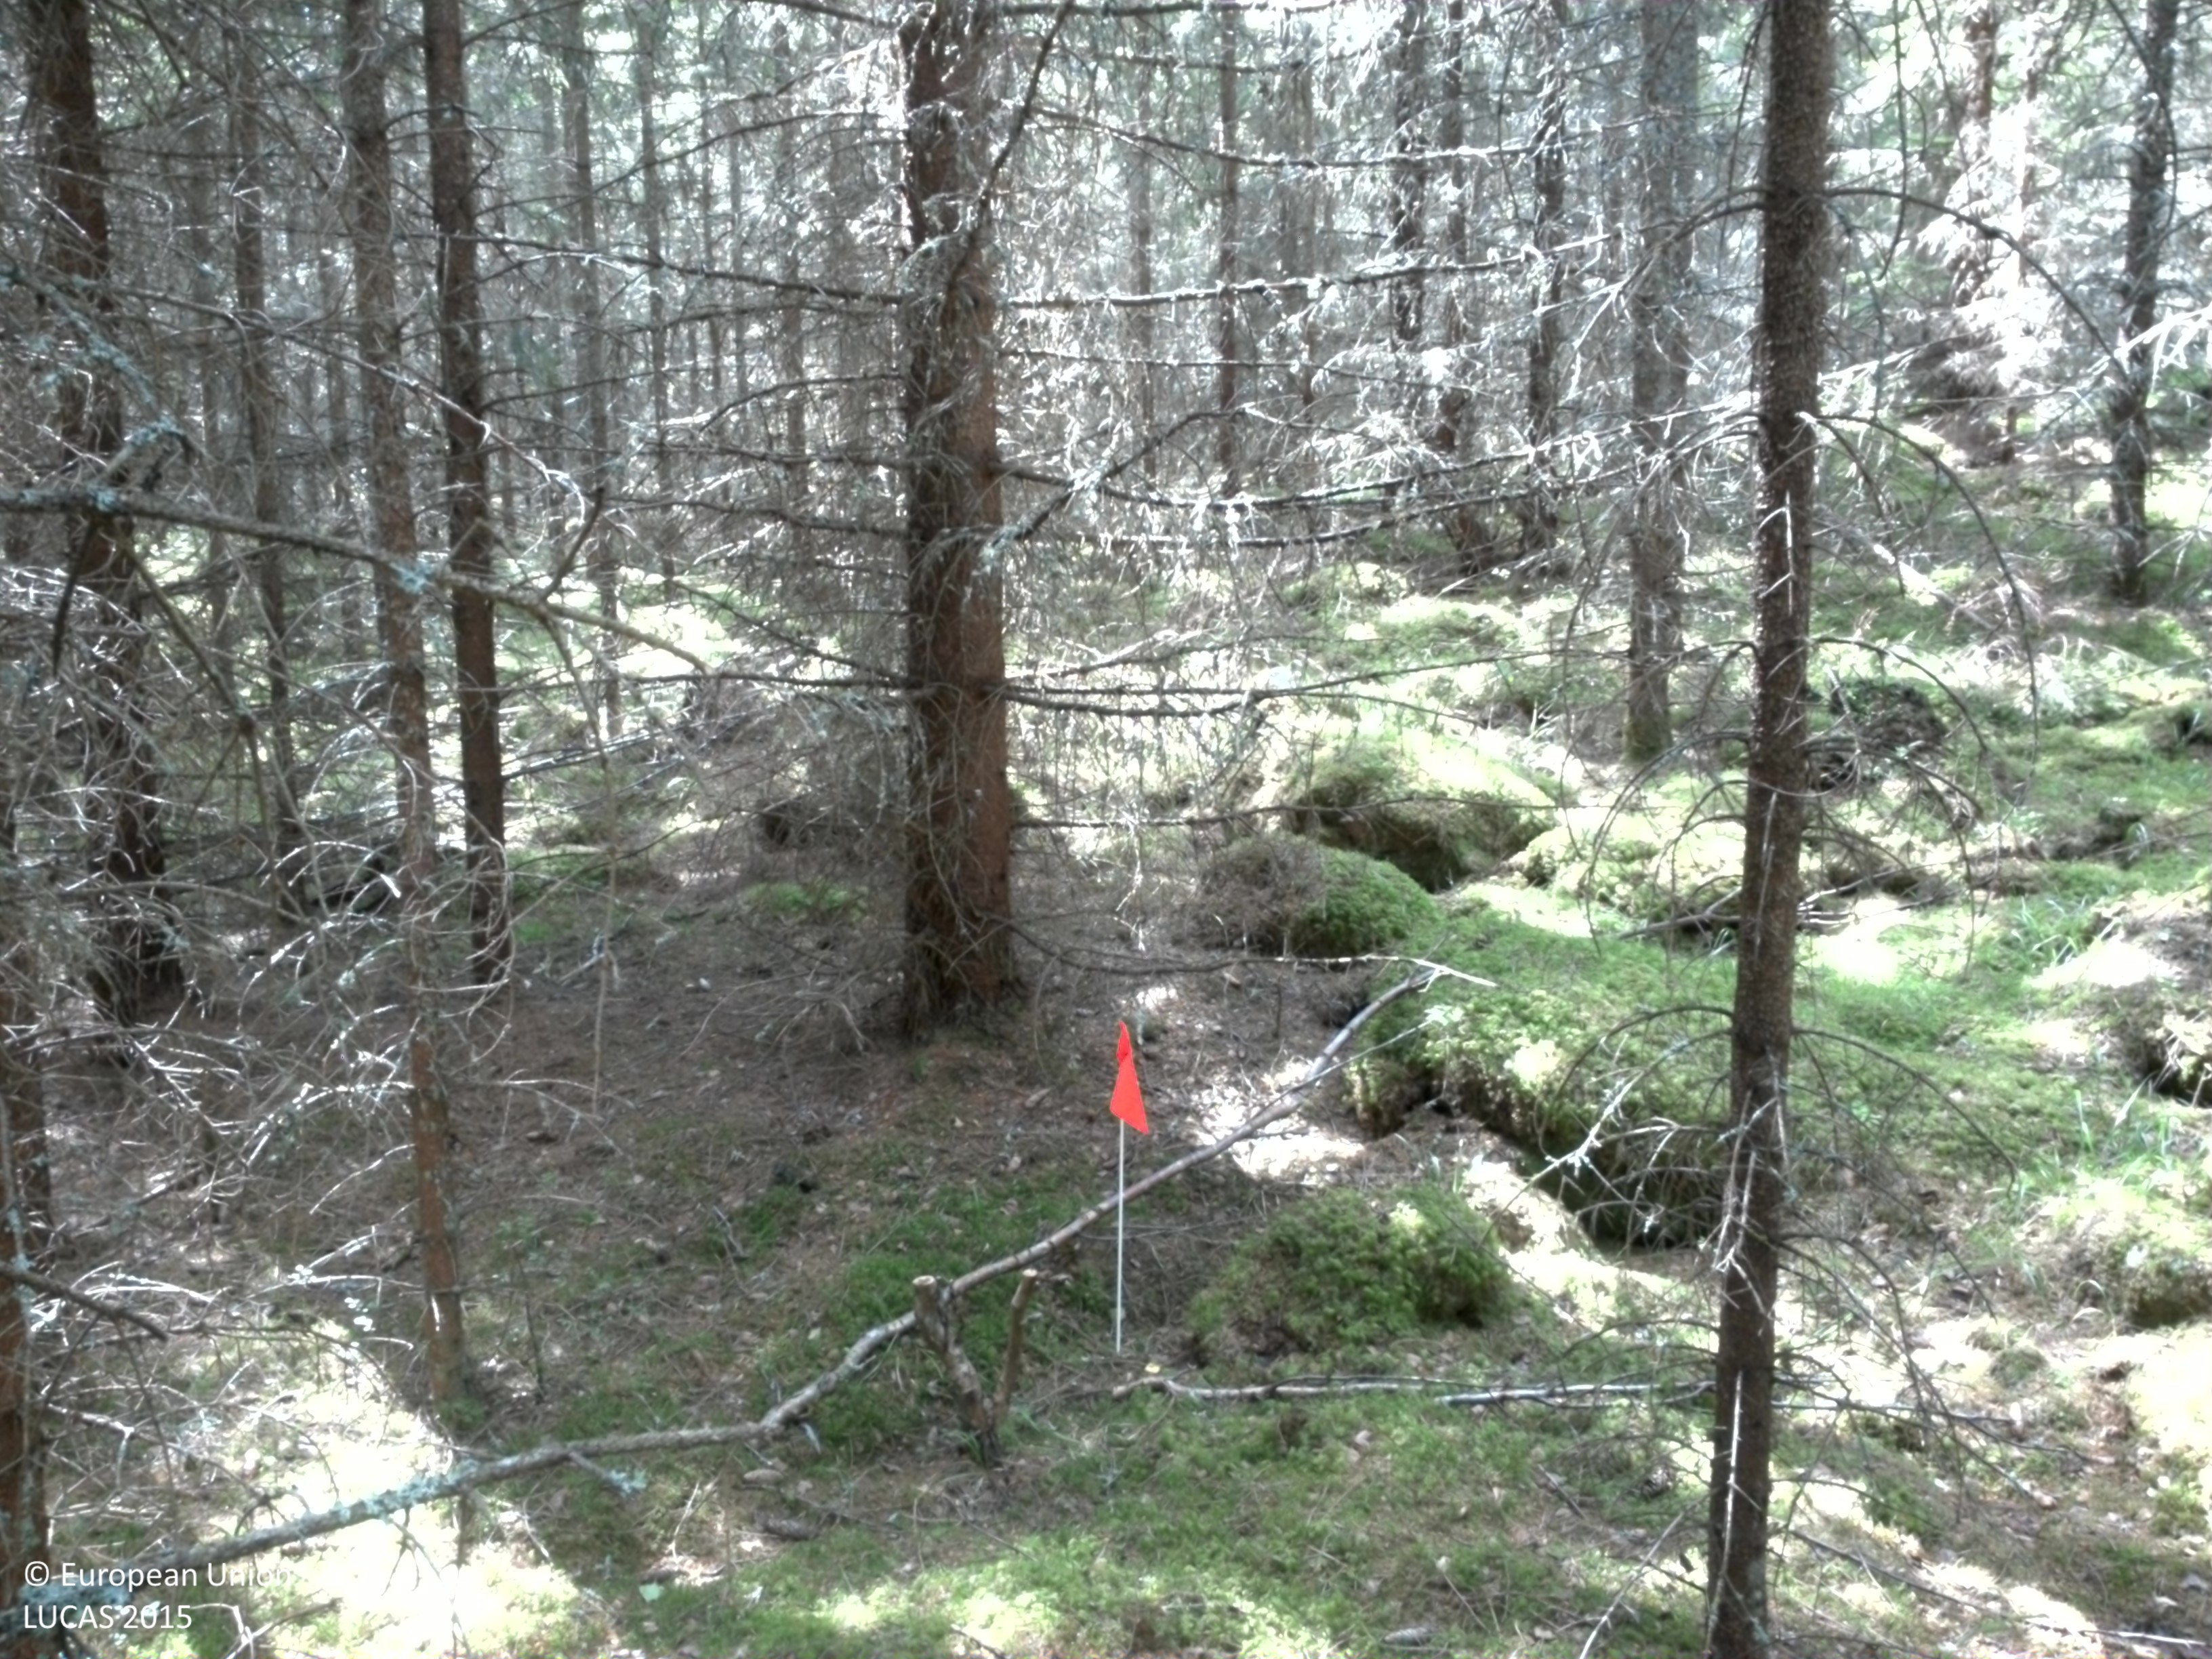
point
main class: Woodland
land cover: Spruce dominated coniferous woodland
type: boreal forest
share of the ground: > 75 %
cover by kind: coniferous forest trees 85 %, lichens and mosses 15 %
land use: Forestry
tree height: > 5 m
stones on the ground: > 50 %
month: July
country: SE
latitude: 59.6159
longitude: 14.6877
